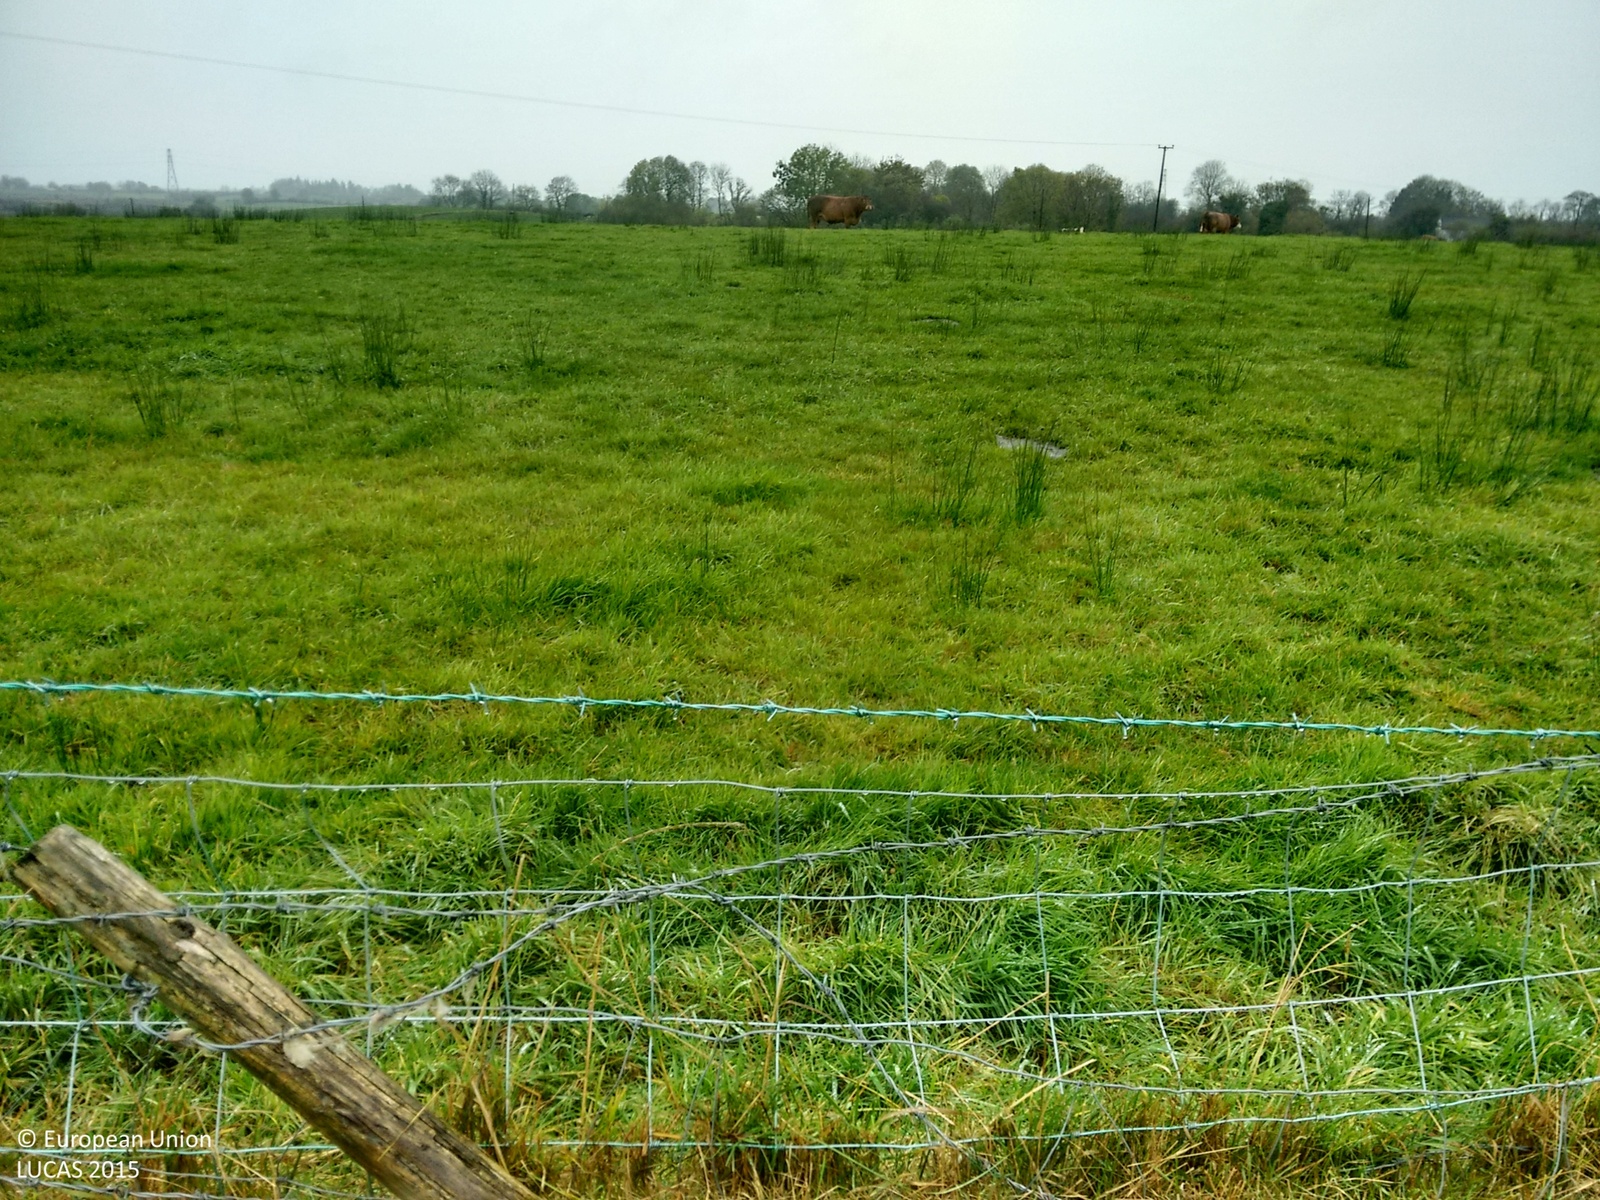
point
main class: Grassland
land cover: Grassland without tree/shrub cover
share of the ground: > 75 %
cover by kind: herbaceous plants 100 %
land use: Agriculture (excluding fallow land and kitchen gardens)
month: October
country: IE
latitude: 53.9045
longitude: -8.2189
